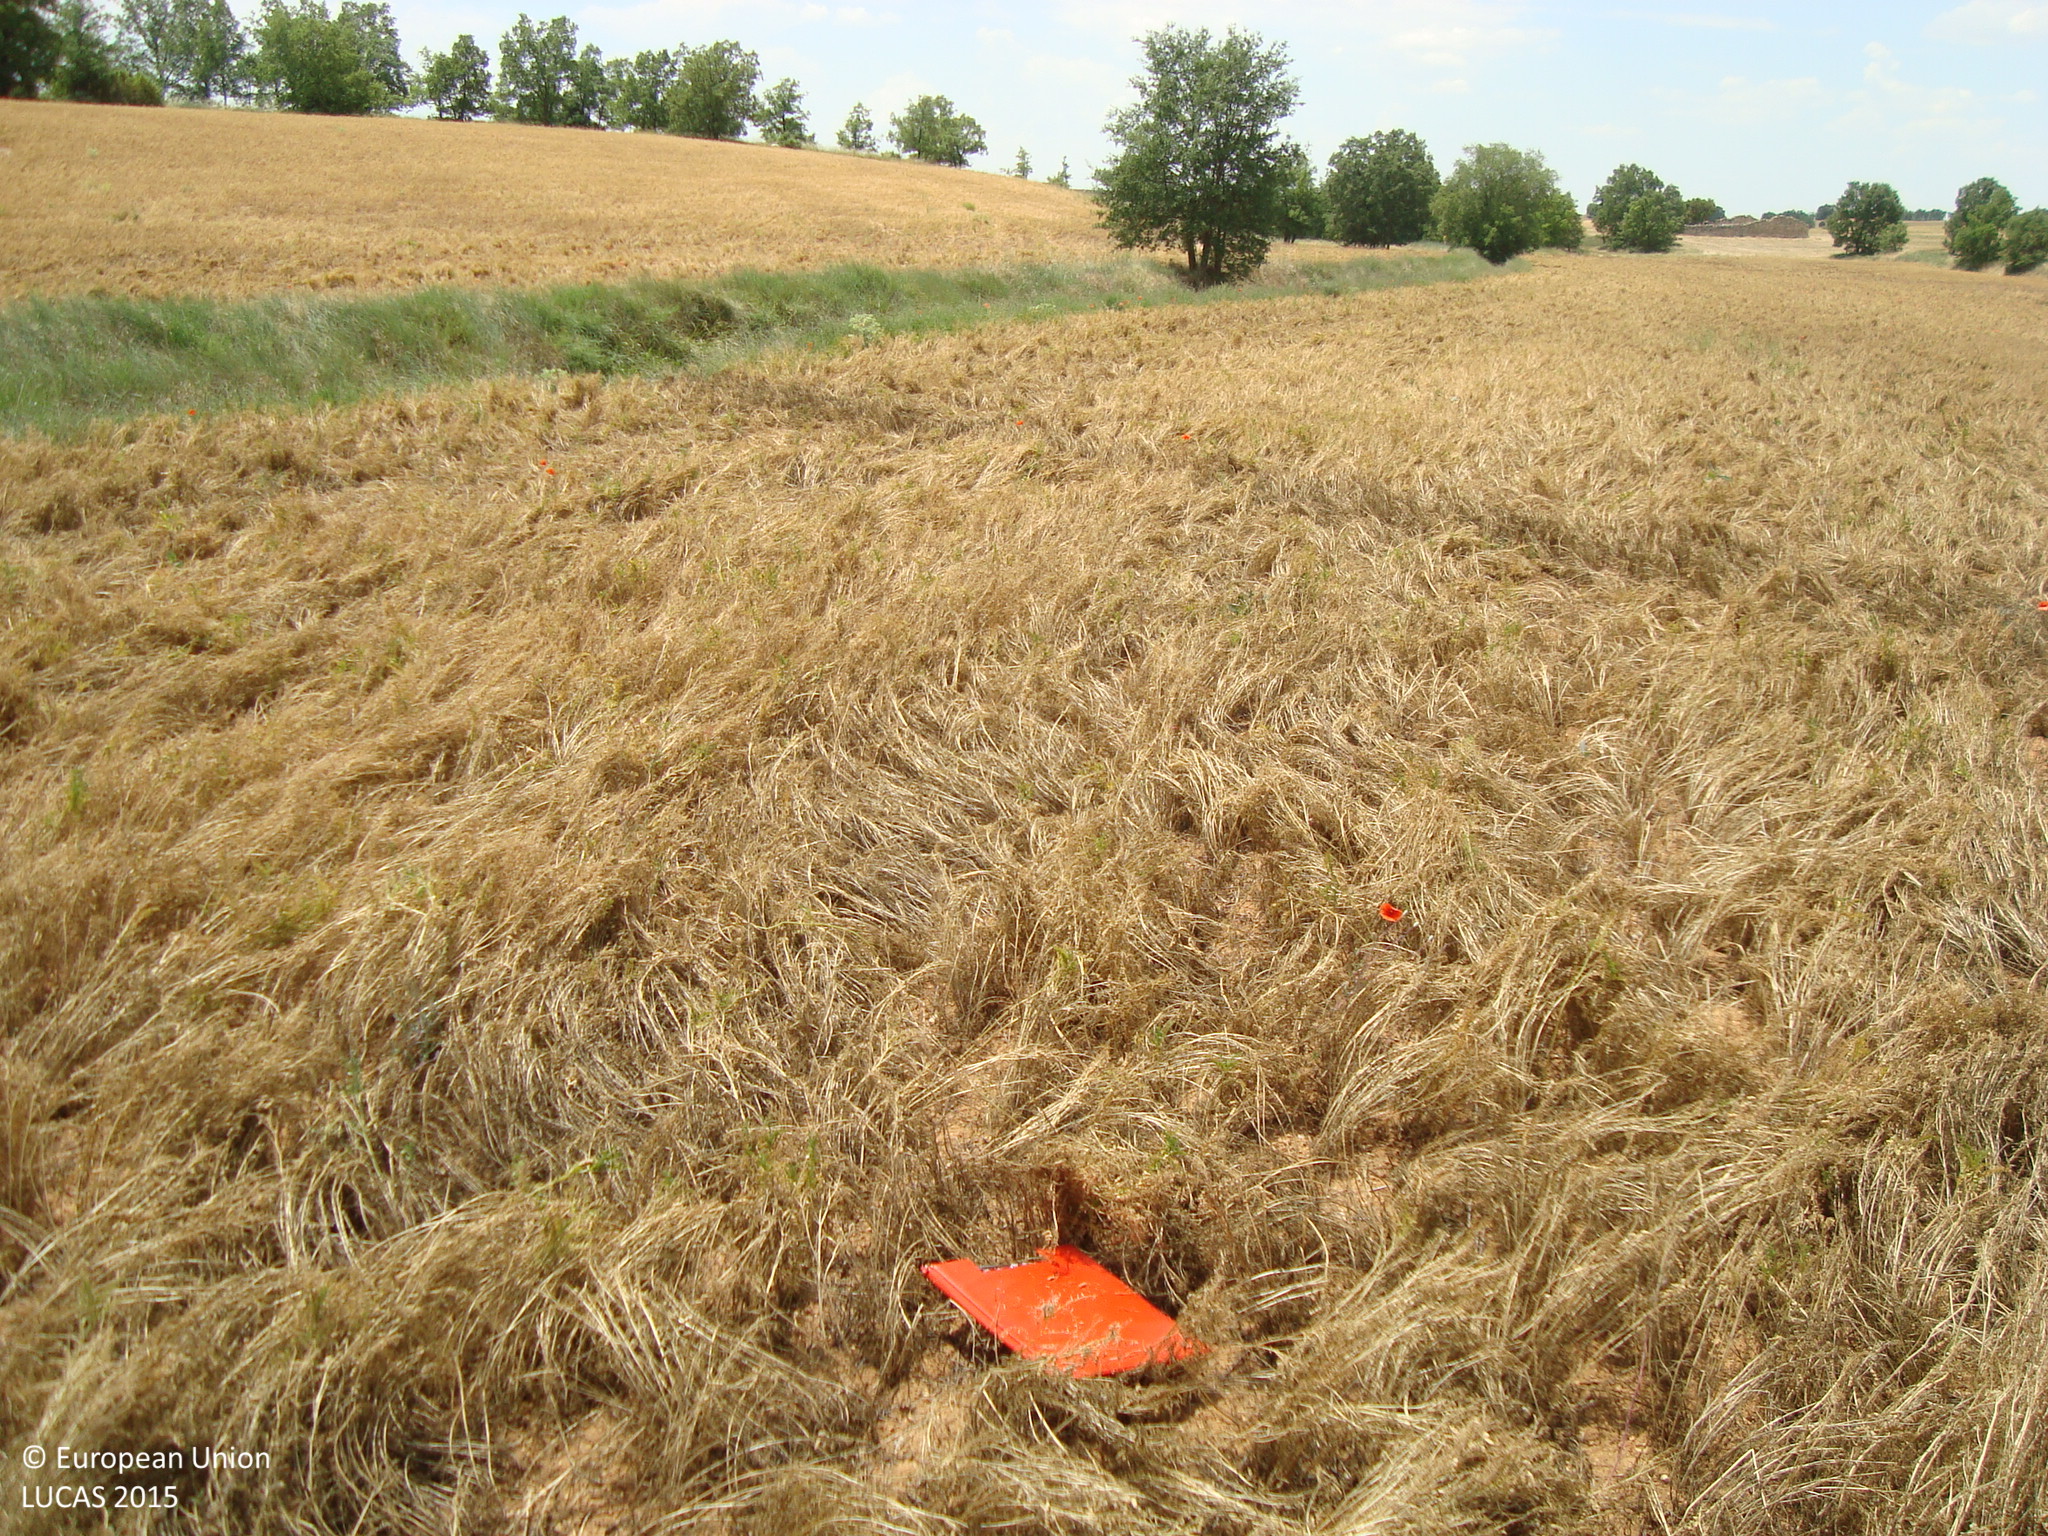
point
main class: Cropland
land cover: Dry pulses
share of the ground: > 75 %
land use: Agriculture (excluding fallow land and kitchen gardens)
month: June
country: ES
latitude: 41.8834
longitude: -3.5623
